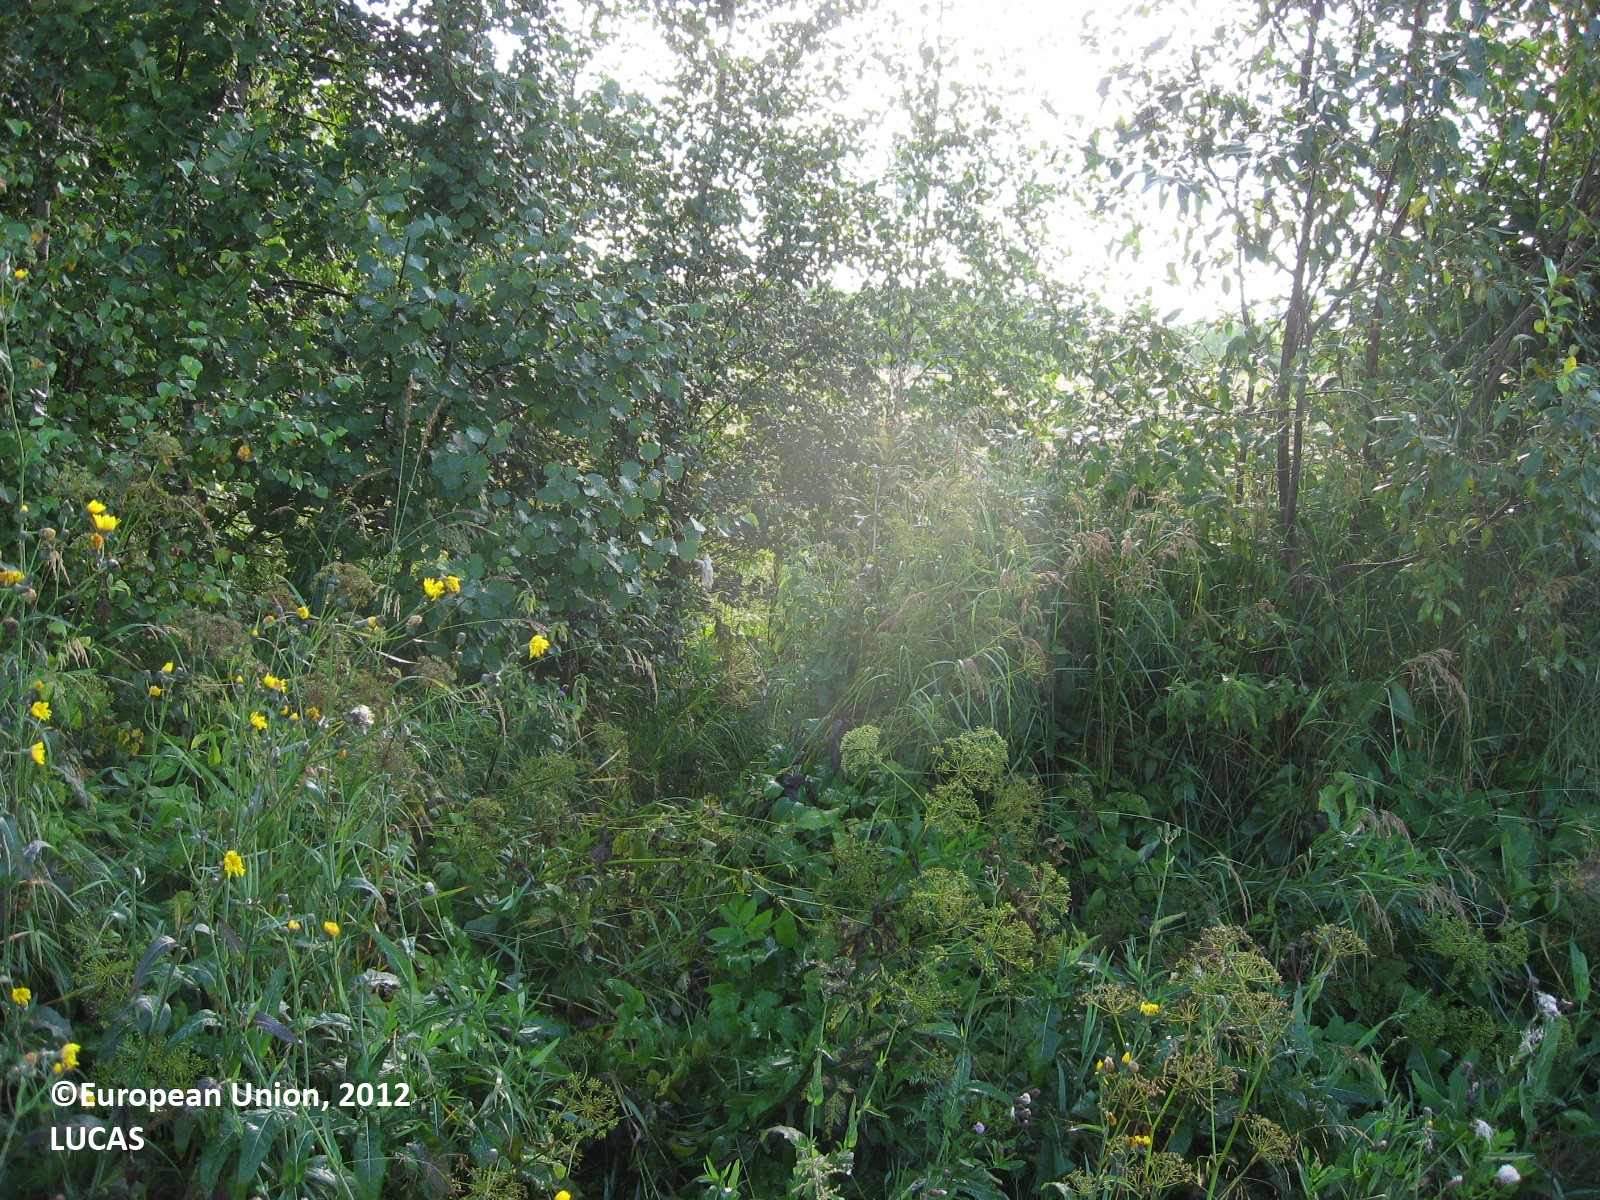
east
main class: Cropland
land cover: Common wheat
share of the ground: > 75 %
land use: Agriculture (excluding fallow land and kitchen gardens)
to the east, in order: Common wheat; Grass margins; Ditches and canals; Spruce dominated mixed woodland; Other mixed woodland; Tracks; Other mixed woodland
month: August
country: FI
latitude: 60.6404
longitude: 25.1685
